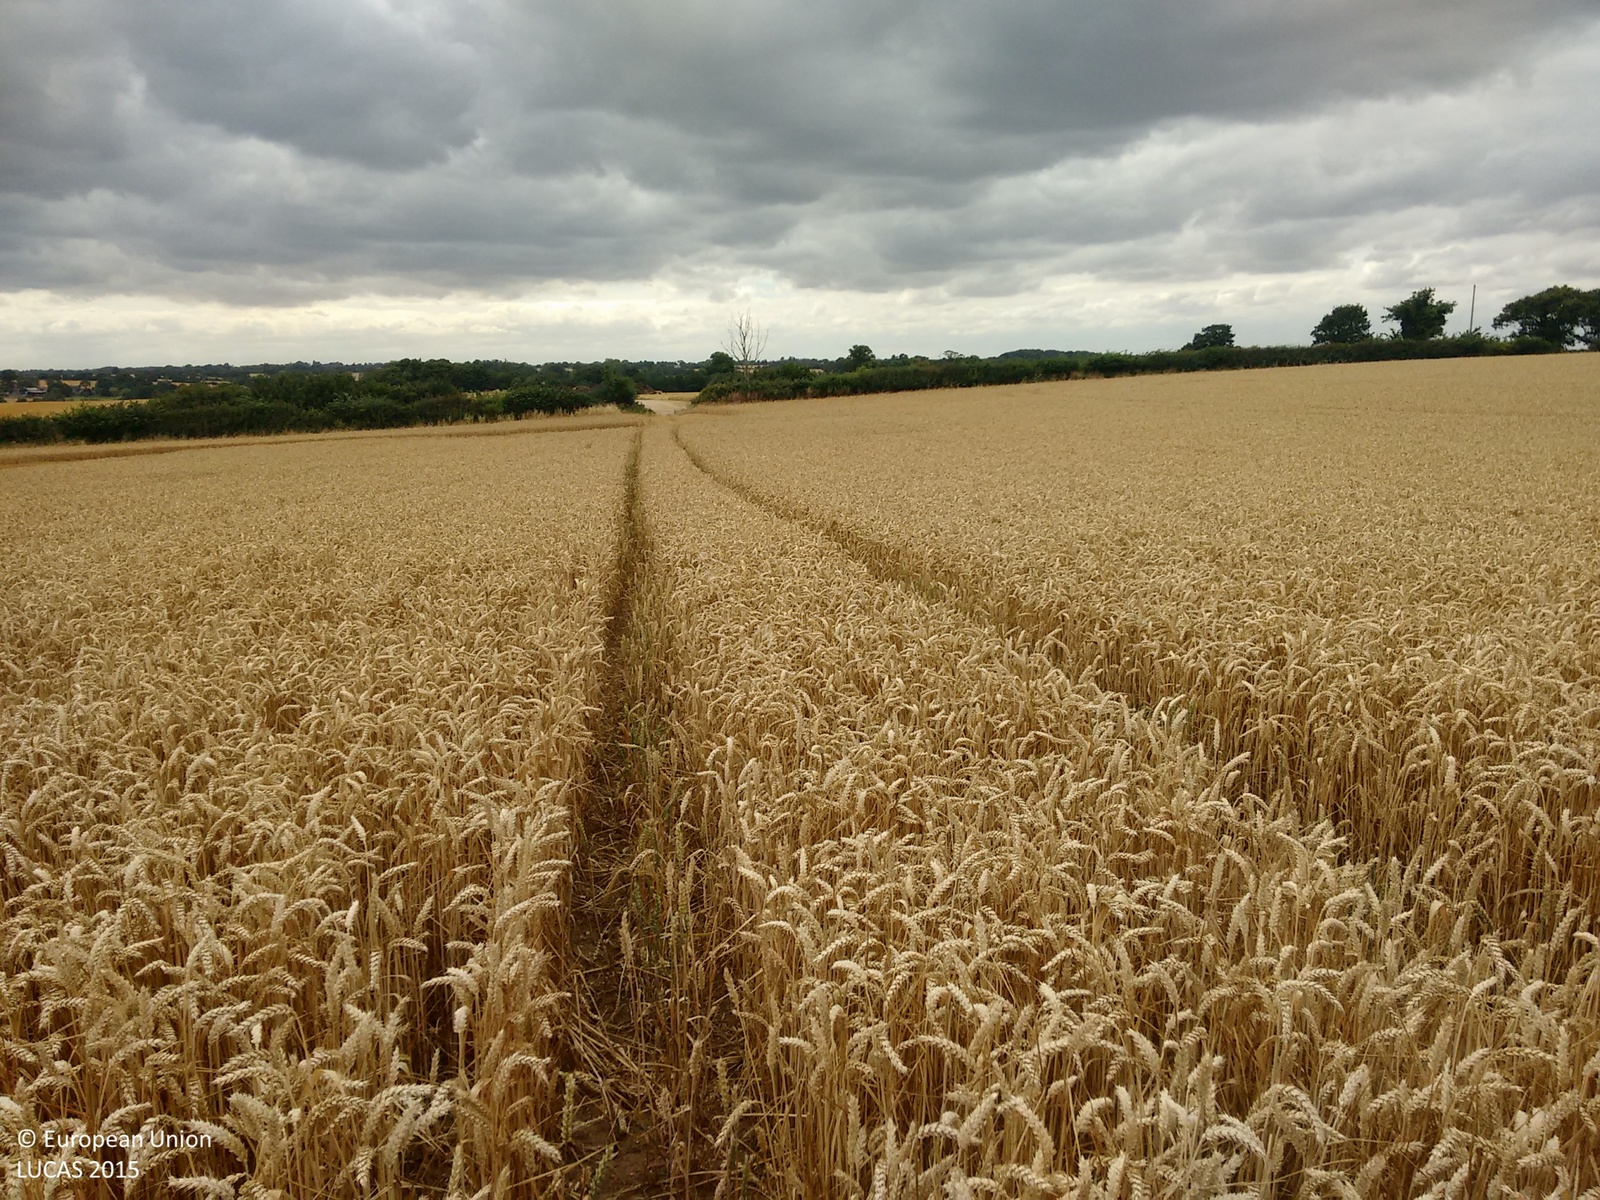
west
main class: Cropland
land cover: Common wheat
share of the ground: > 75 %
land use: Agriculture (excluding fallow land and kitchen gardens)
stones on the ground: 10 - 25 %
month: August
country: GB
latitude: 51.9261
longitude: 0.5349
